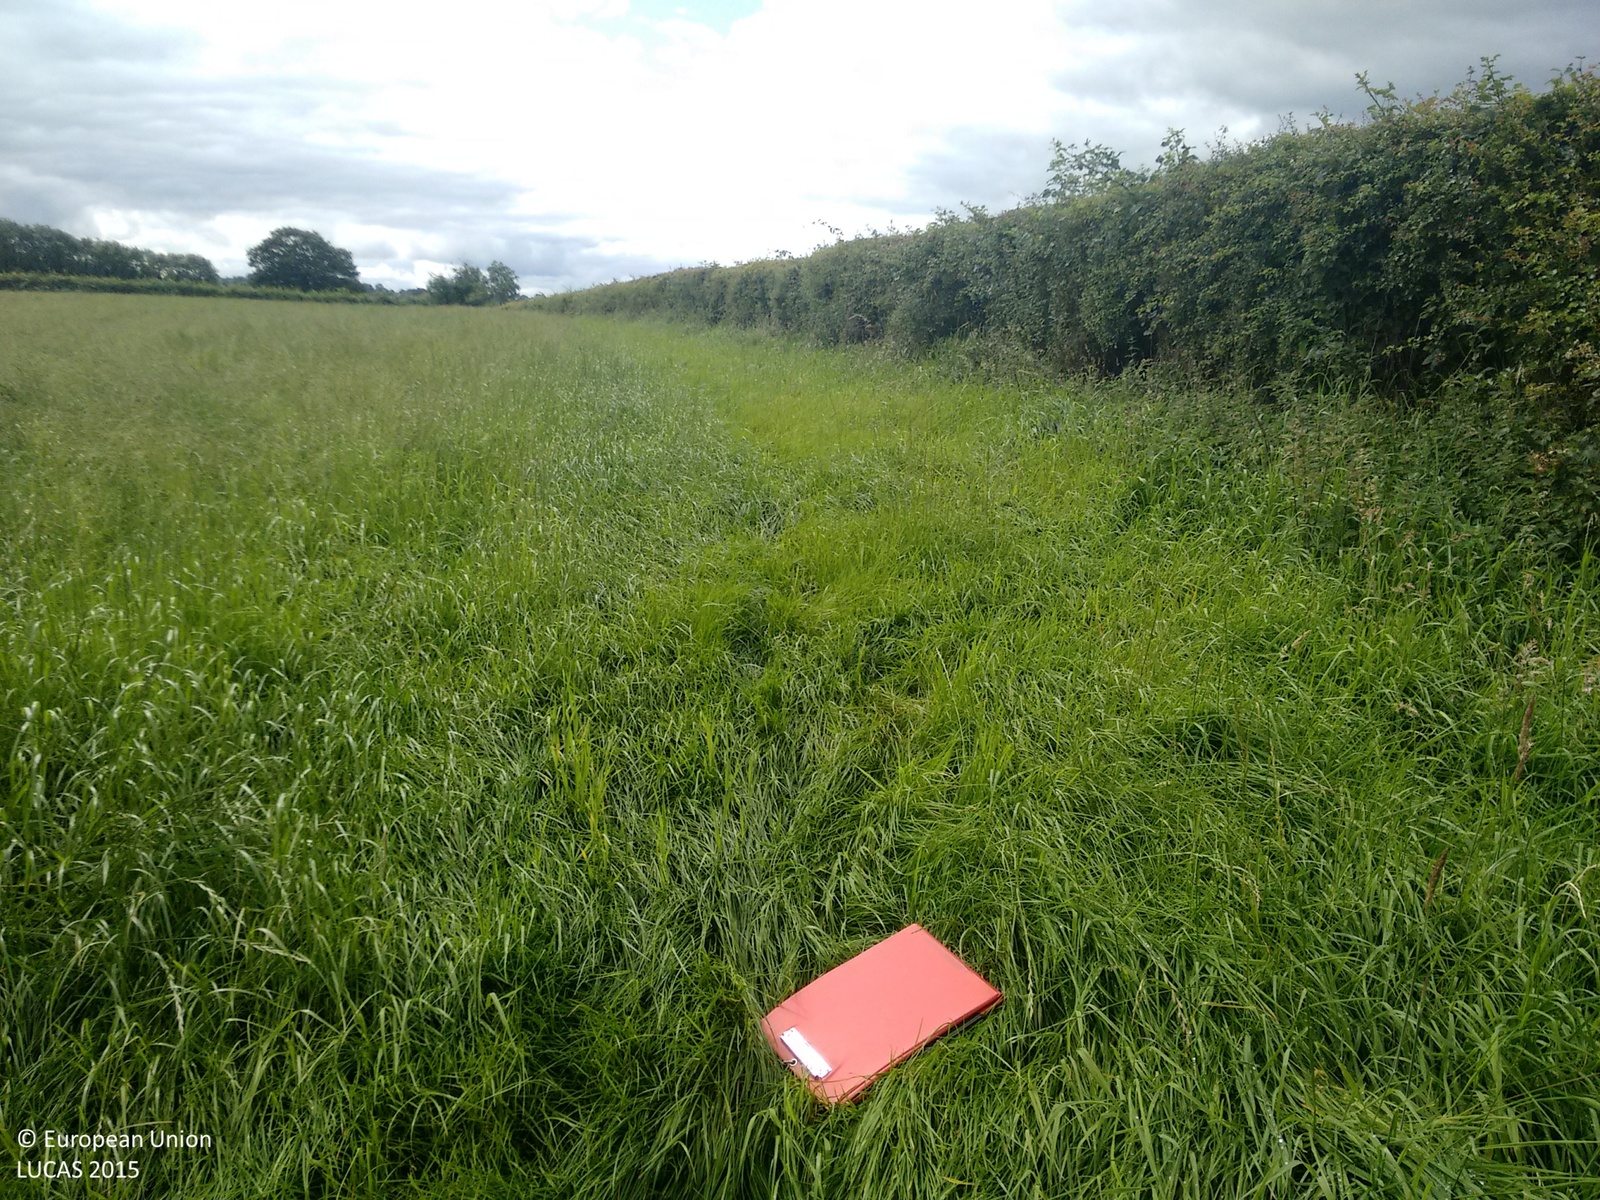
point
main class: Grassland
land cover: Grassland without tree/shrub cover
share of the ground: > 75 %
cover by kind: herbaceous plants 100 %
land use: Agriculture (excluding fallow land and kitchen gardens)
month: August
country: GB
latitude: 54.3114
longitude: -6.8114
